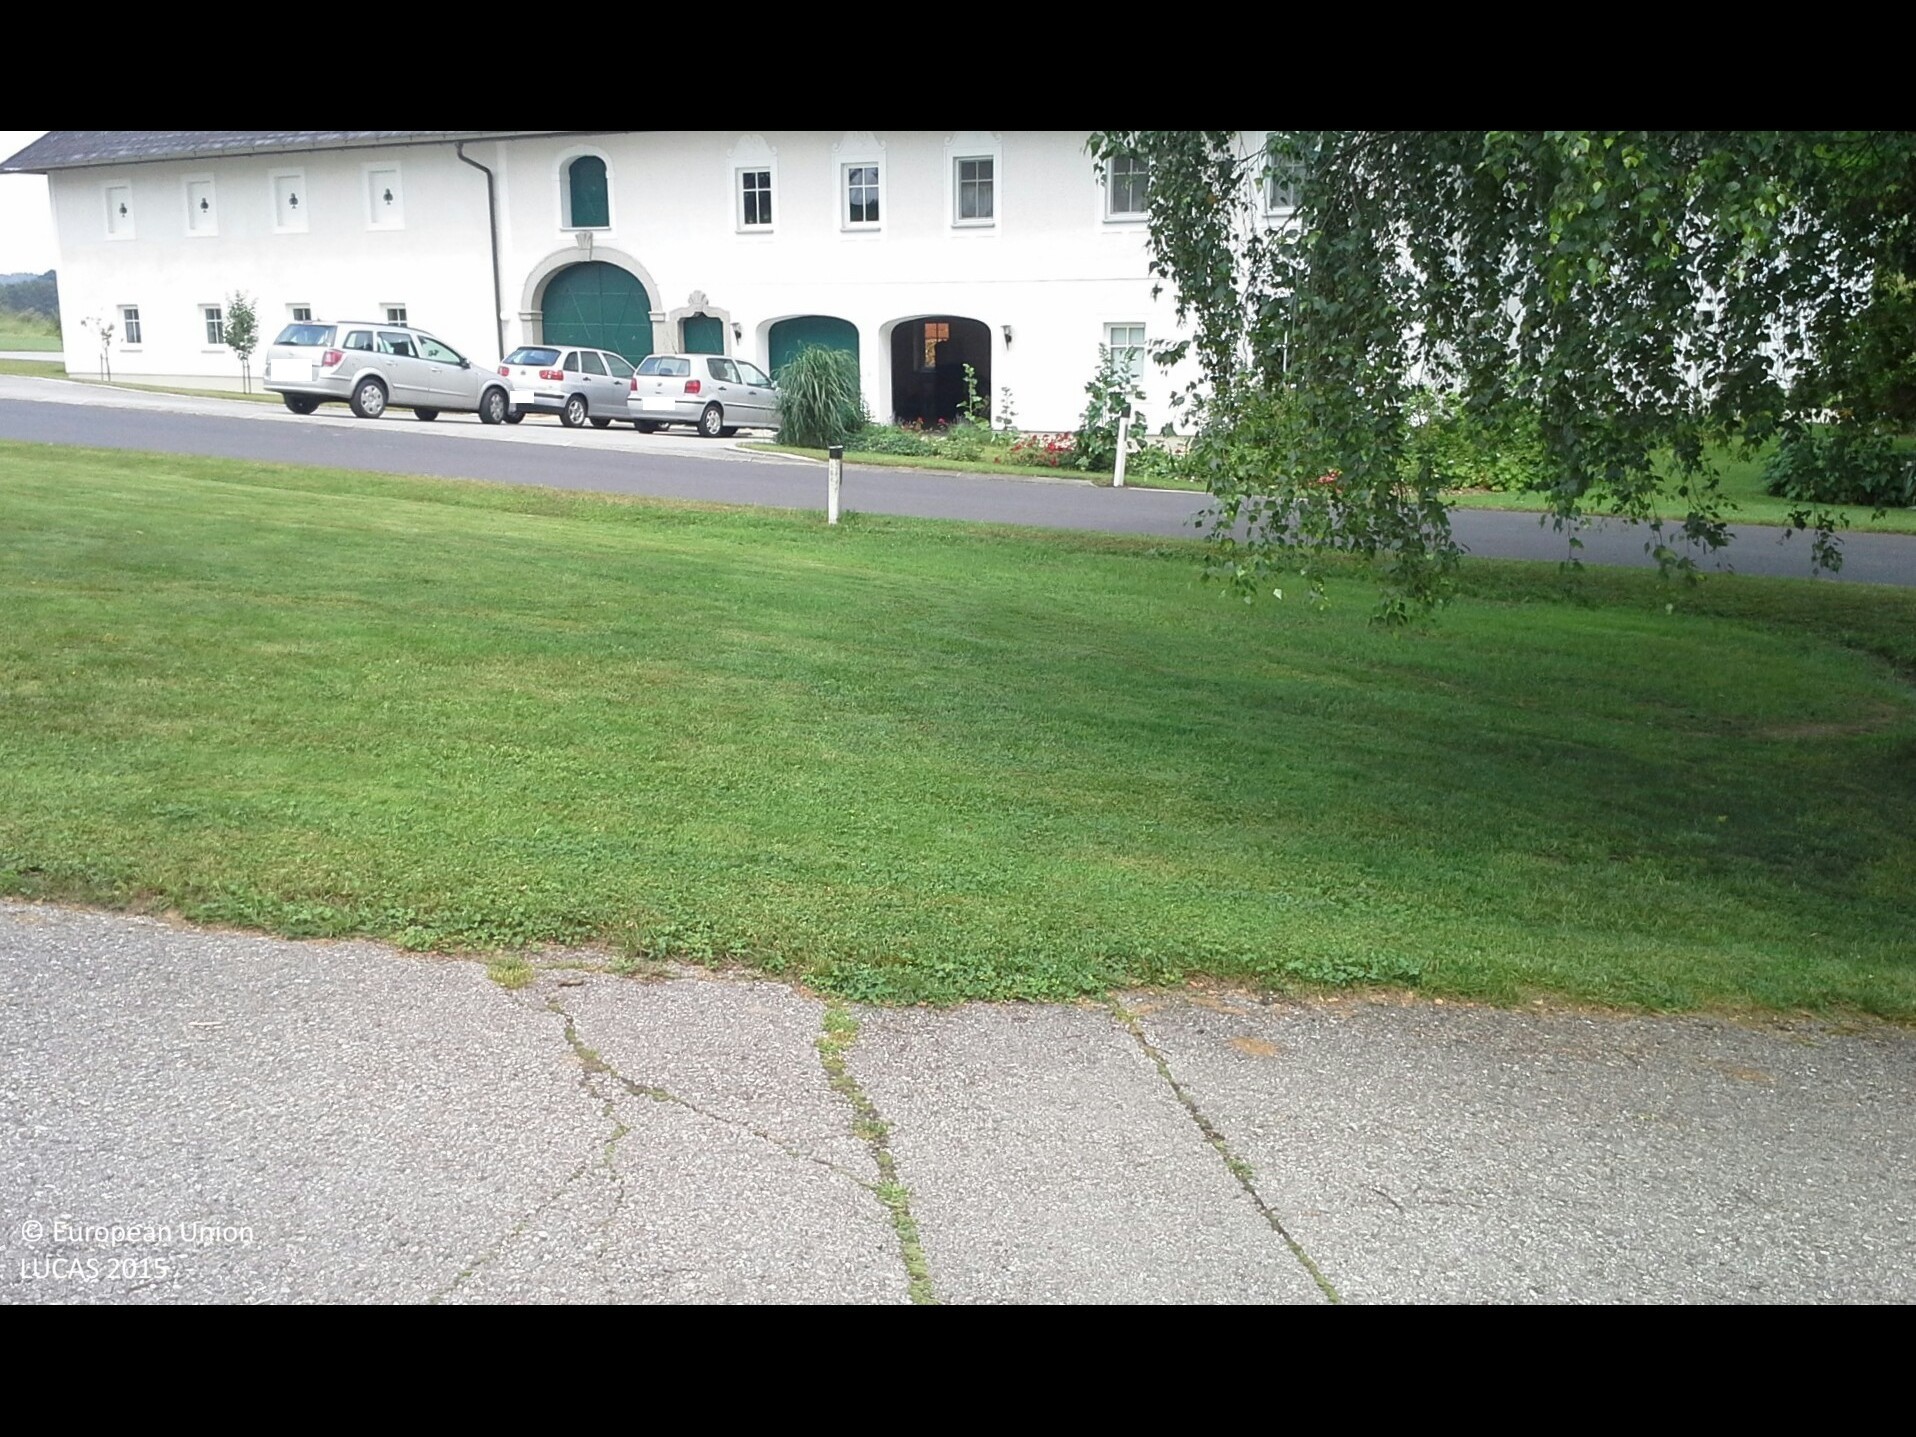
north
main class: Grassland
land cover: Grassland without tree/shrub cover
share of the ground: > 75 %
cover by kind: herbaceous plants 100 %
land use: Residential
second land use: Agriculture (excluding fallow land and kitchen gardens)
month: June
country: AT
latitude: 48.0853
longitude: 14.3092
